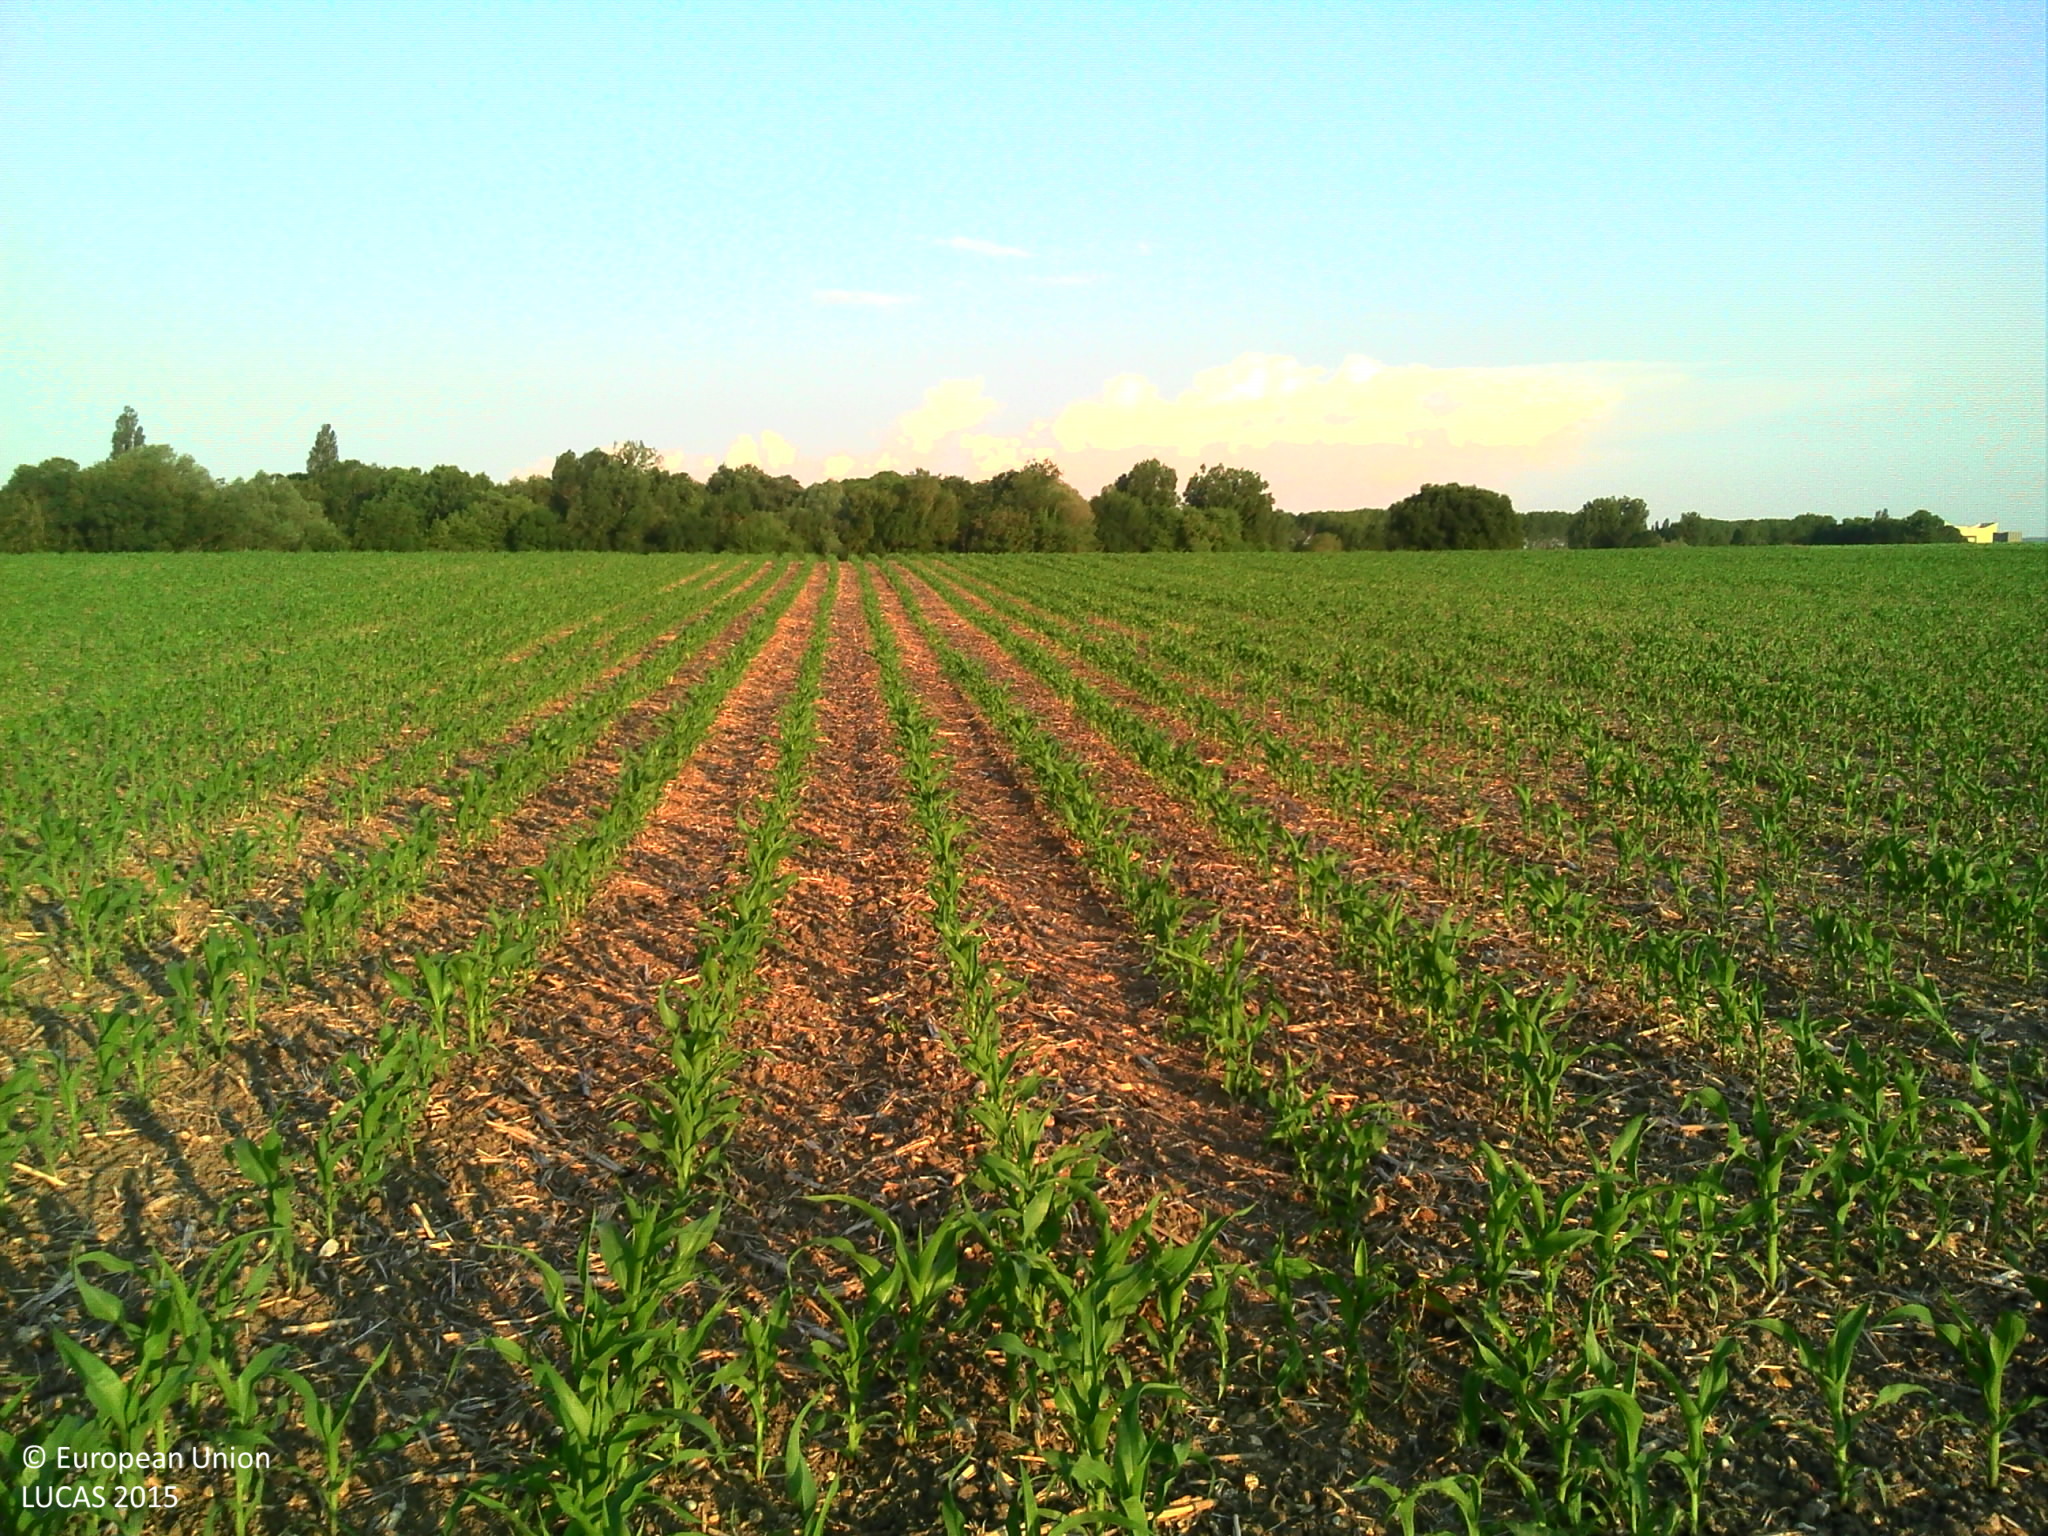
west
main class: Cropland
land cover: Maize
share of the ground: 25 - 50 %
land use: Agriculture (excluding fallow land and kitchen gardens)
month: June
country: FR
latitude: 46.7852
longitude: 0.5639
